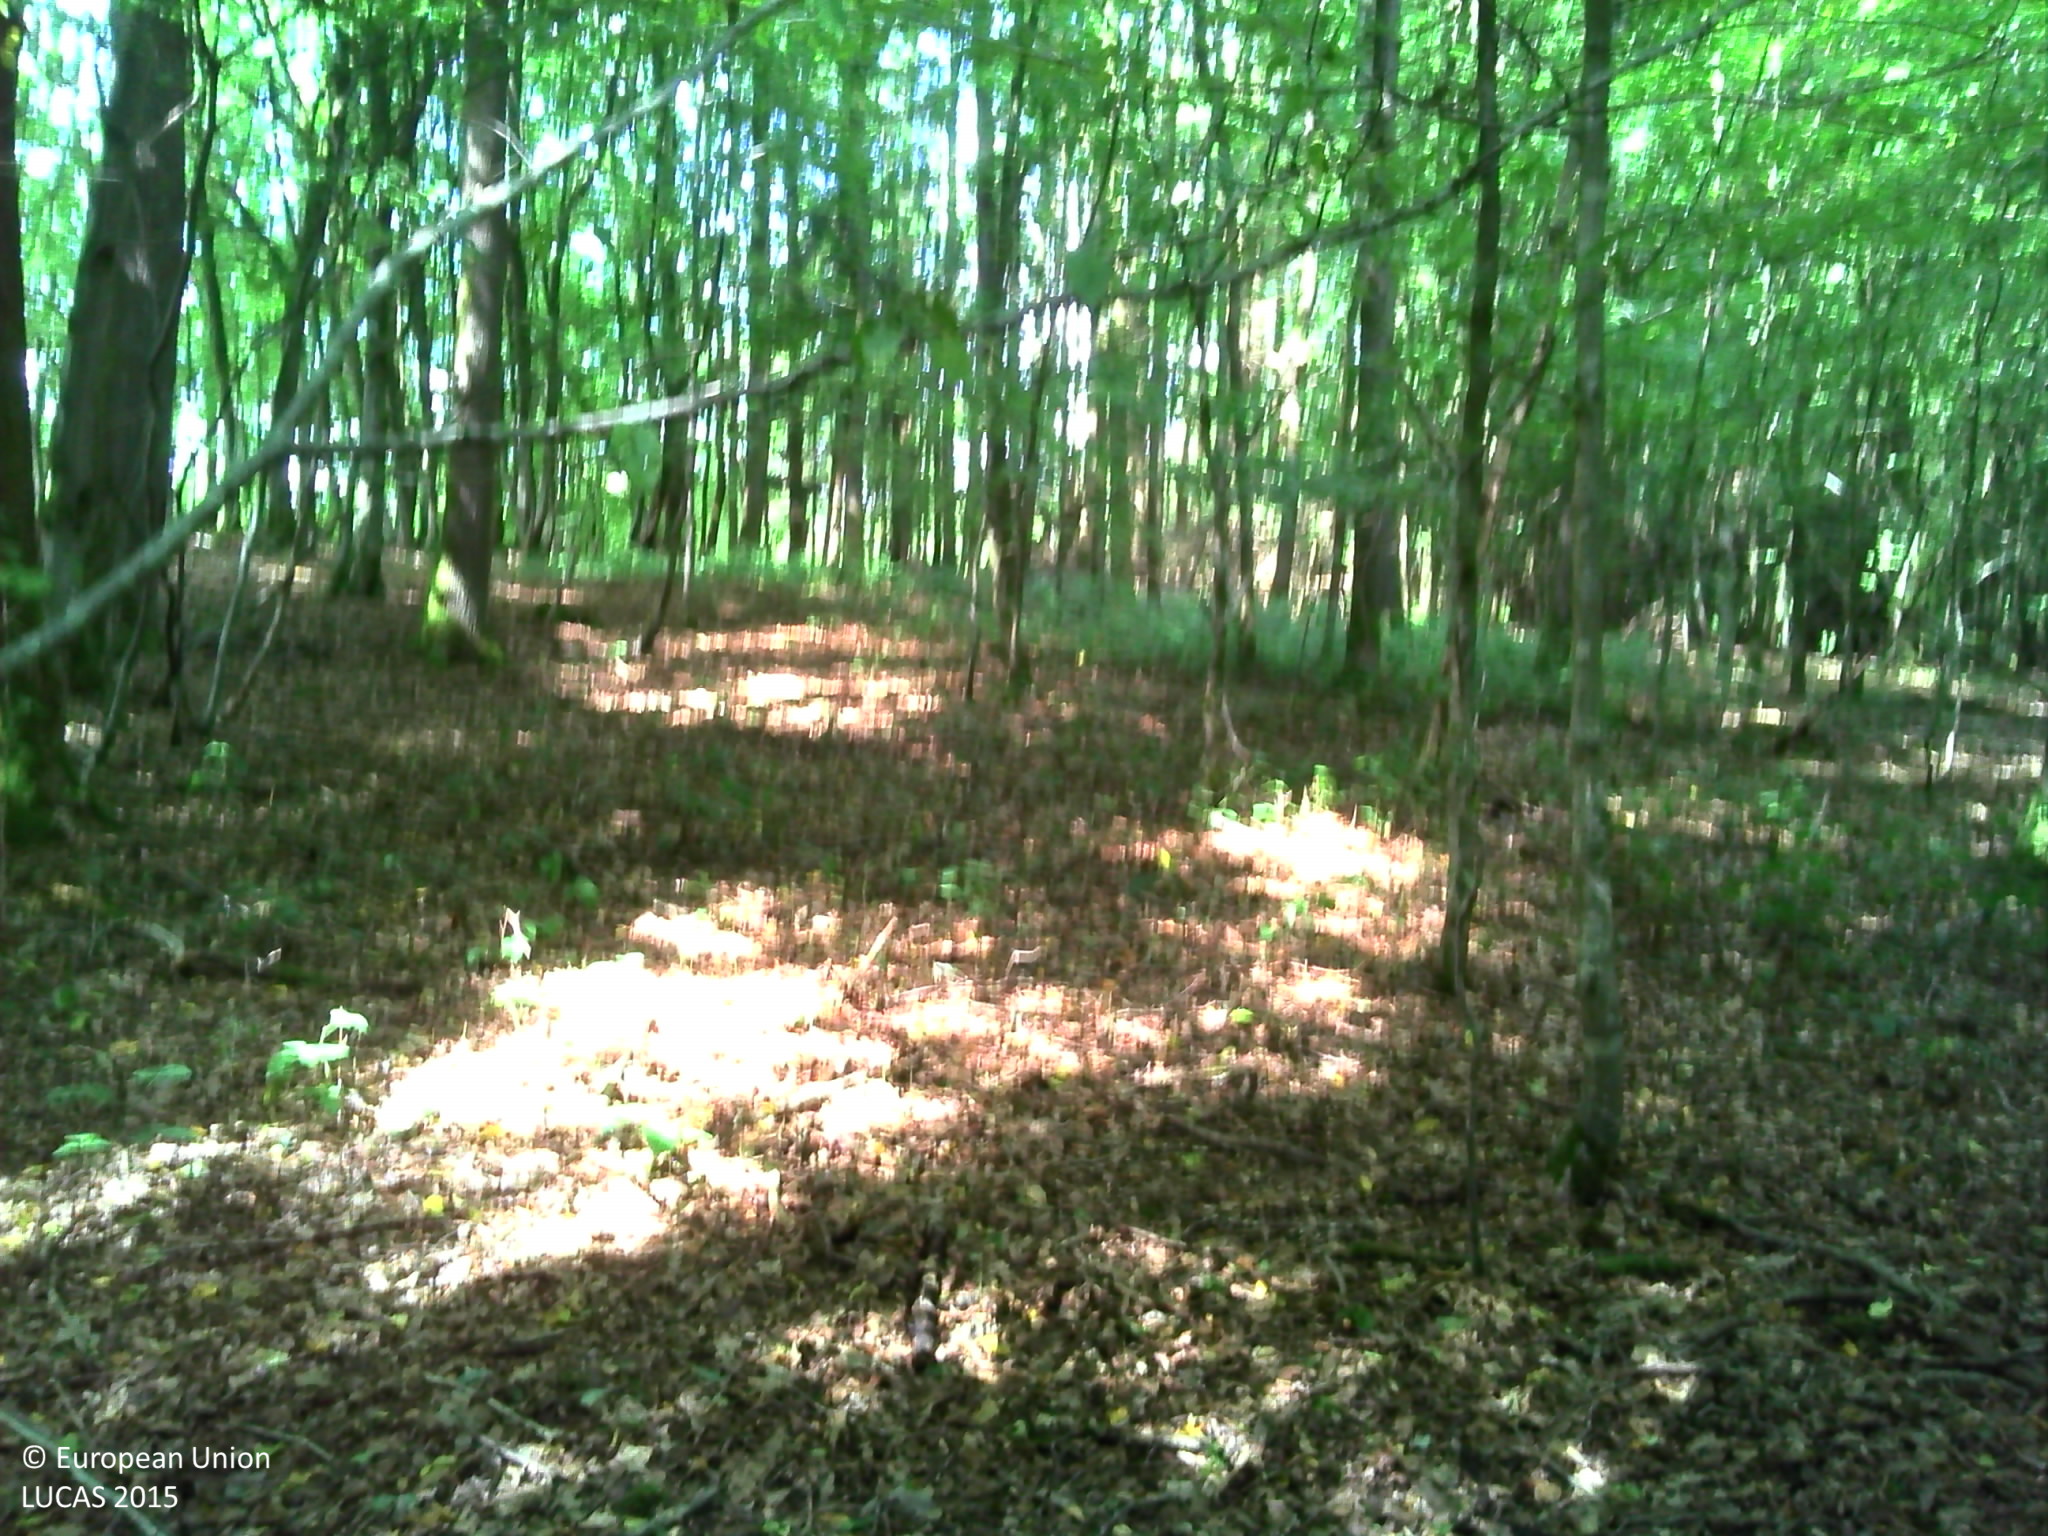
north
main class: Woodland
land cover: Broadleaved woodland
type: mesophytic deciduous forest
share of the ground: > 75 %
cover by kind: broadleaved forest trees 90 %, herbaceous plants 10 %
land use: Forestry
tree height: > 5 m
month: July
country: BE
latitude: 50.1181
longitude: 4.3874
